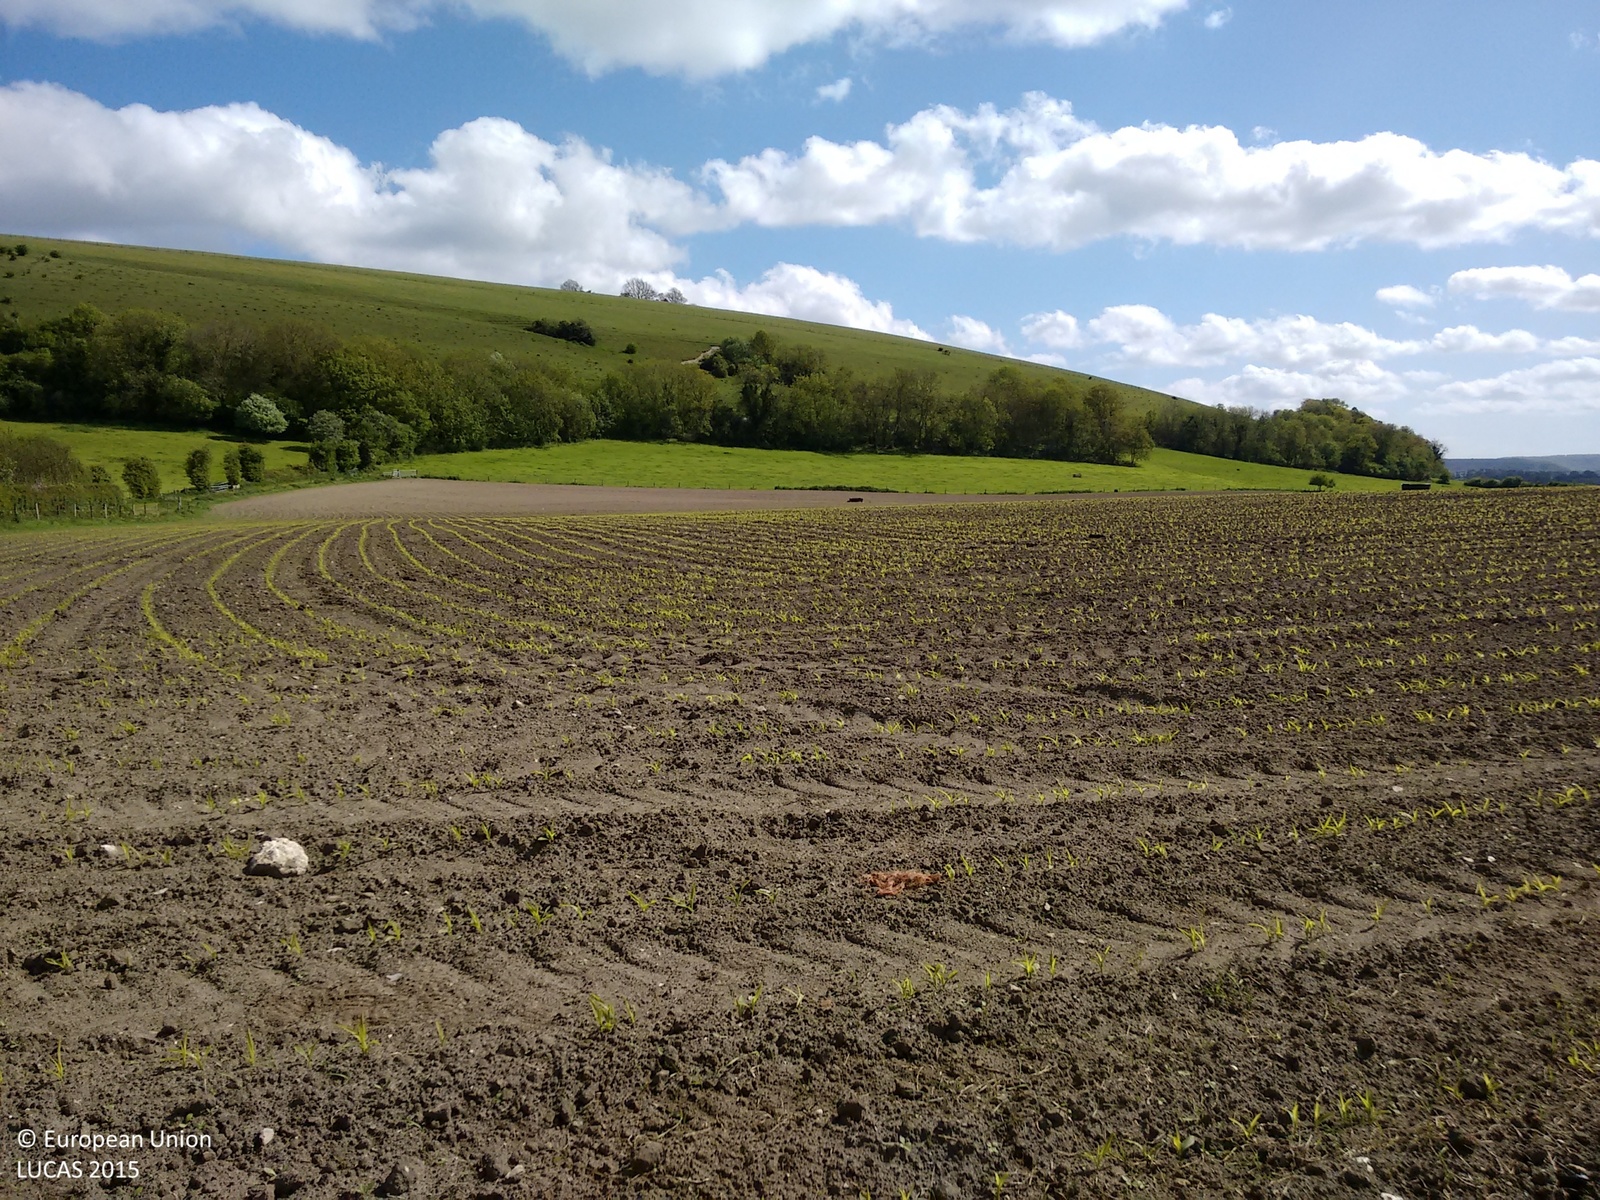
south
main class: Grassland
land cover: Grassland without tree/shrub cover
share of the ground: > 75 %
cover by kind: herbaceous plants 100 %
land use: Agriculture (excluding fallow land and kitchen gardens)
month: May
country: GB
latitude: 50.9654
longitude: -2.1785
